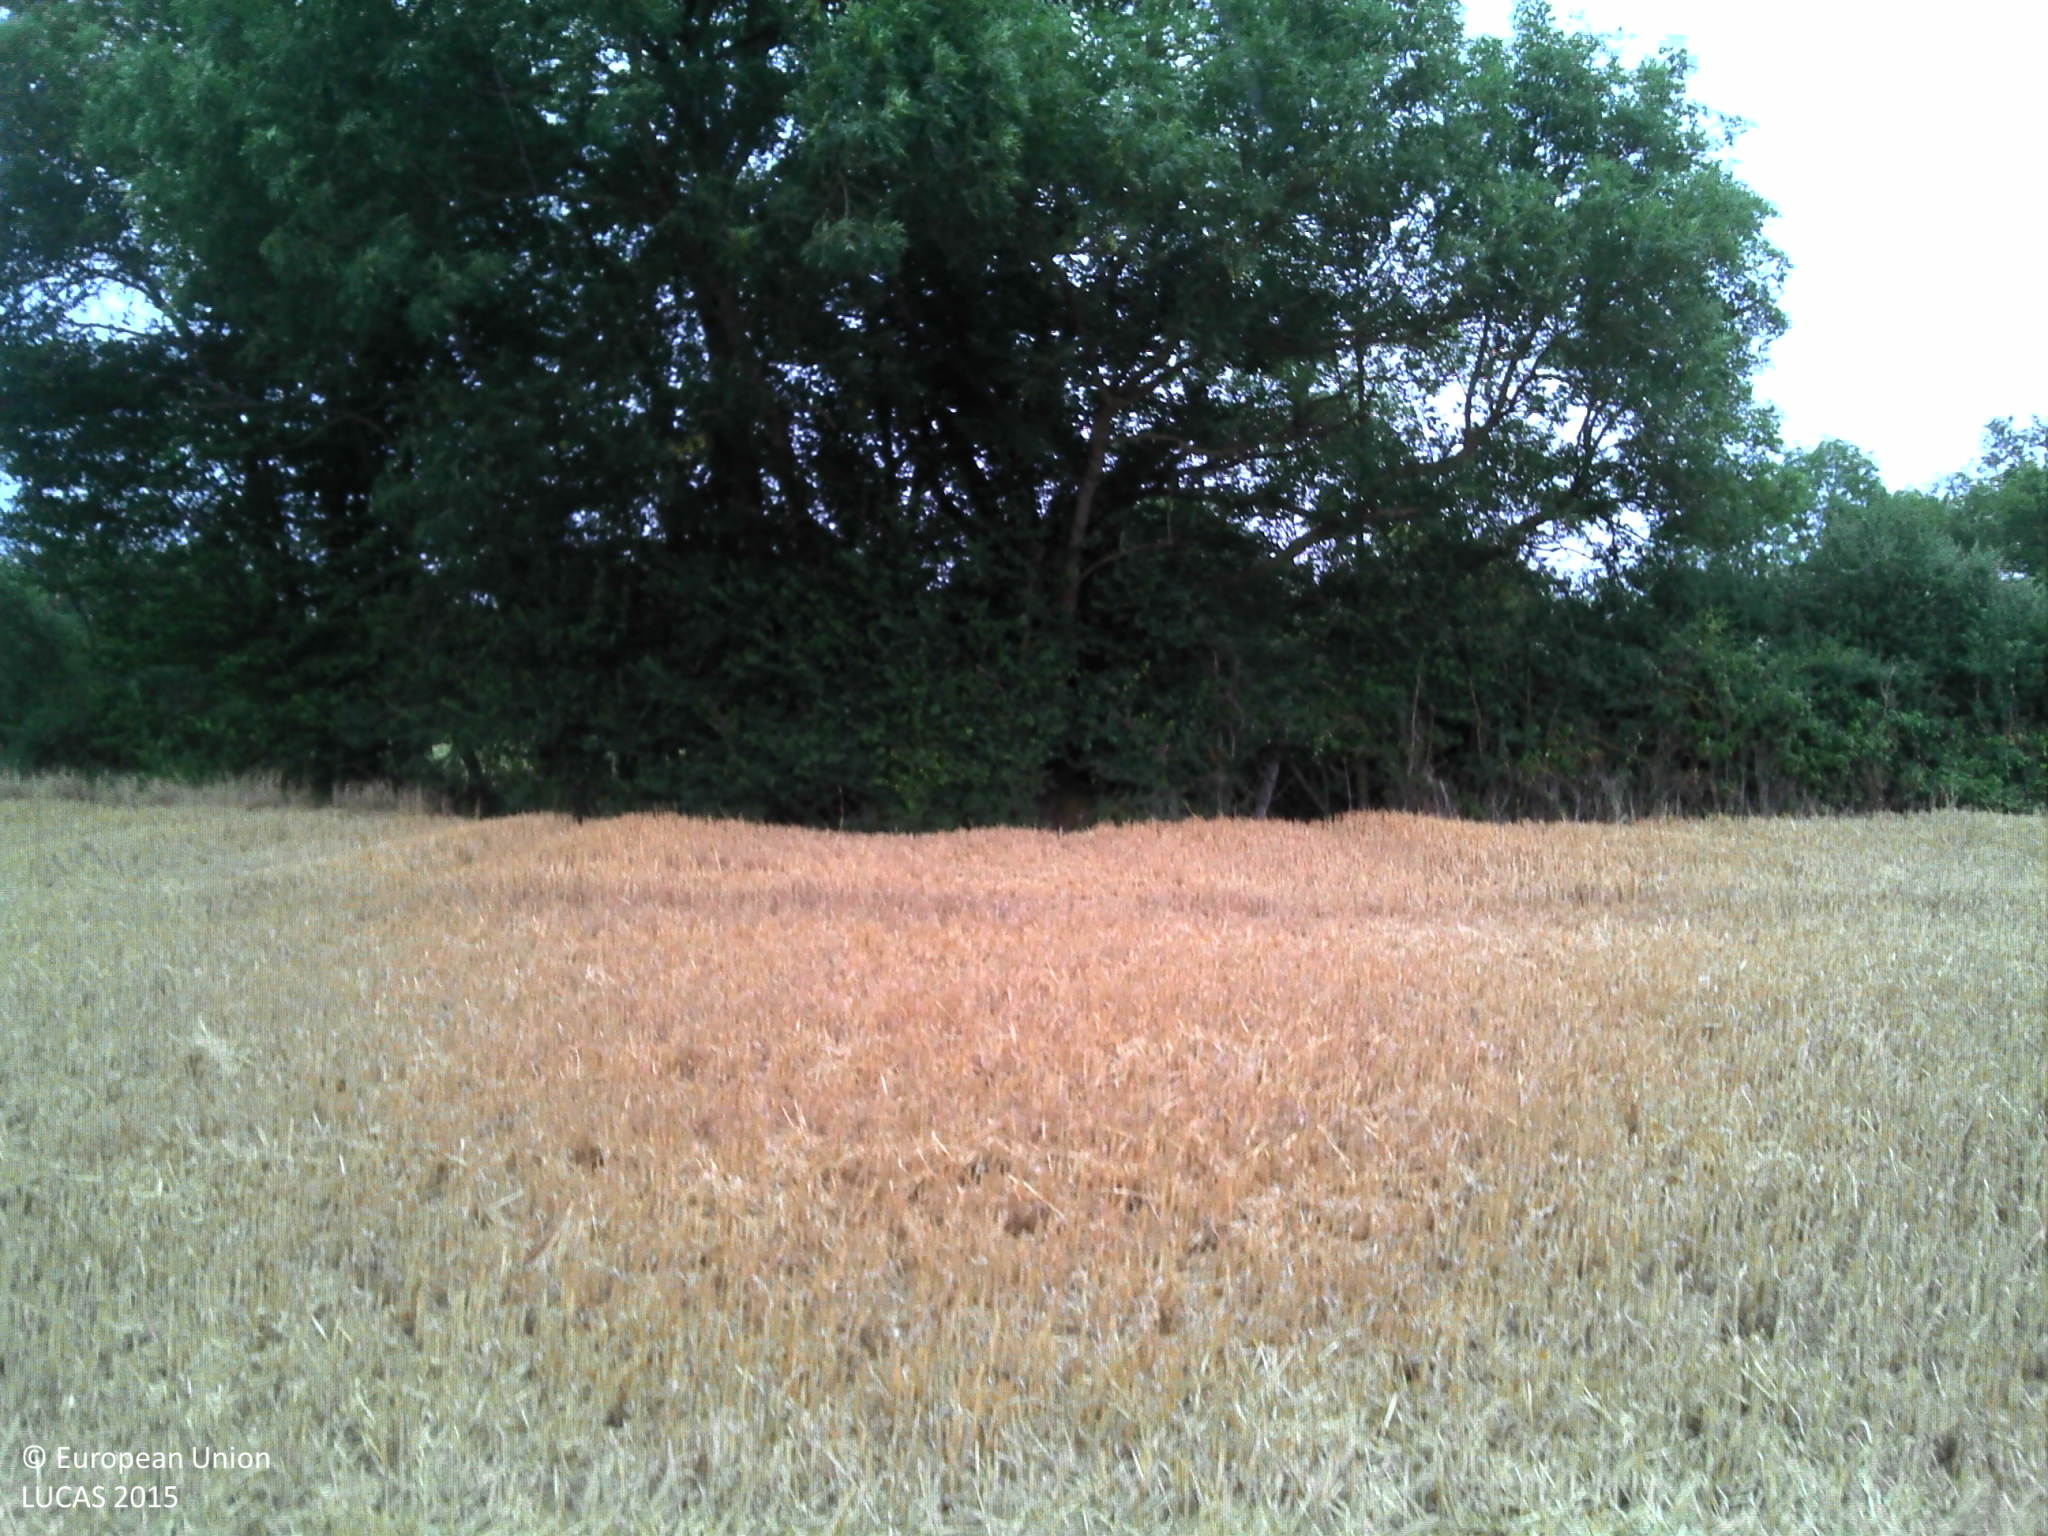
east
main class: Cropland
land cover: Common wheat
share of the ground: > 75 %
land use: Agriculture (excluding fallow land and kitchen gardens)
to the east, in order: Common wheat; Abandoned hedges; Fences; Grassland without tree/shrub cover; Fences; Broadleaved woodland; Grassland without tree/shrub cover; Fences; Abandoned hedges; Fences; Broadleaved woodland; Artificial constructions in urban areas; Grassland without tree/shrub cover; Fences; Ditches and canals; Grass margins; Paved roads, cycling and walking lanes; Grass margins; Ditches and canals; Electric lines; Abandoned hedges; Other leguminous and mixtures for fodder
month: July
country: FR
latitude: 46.8056
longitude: 2.1695
